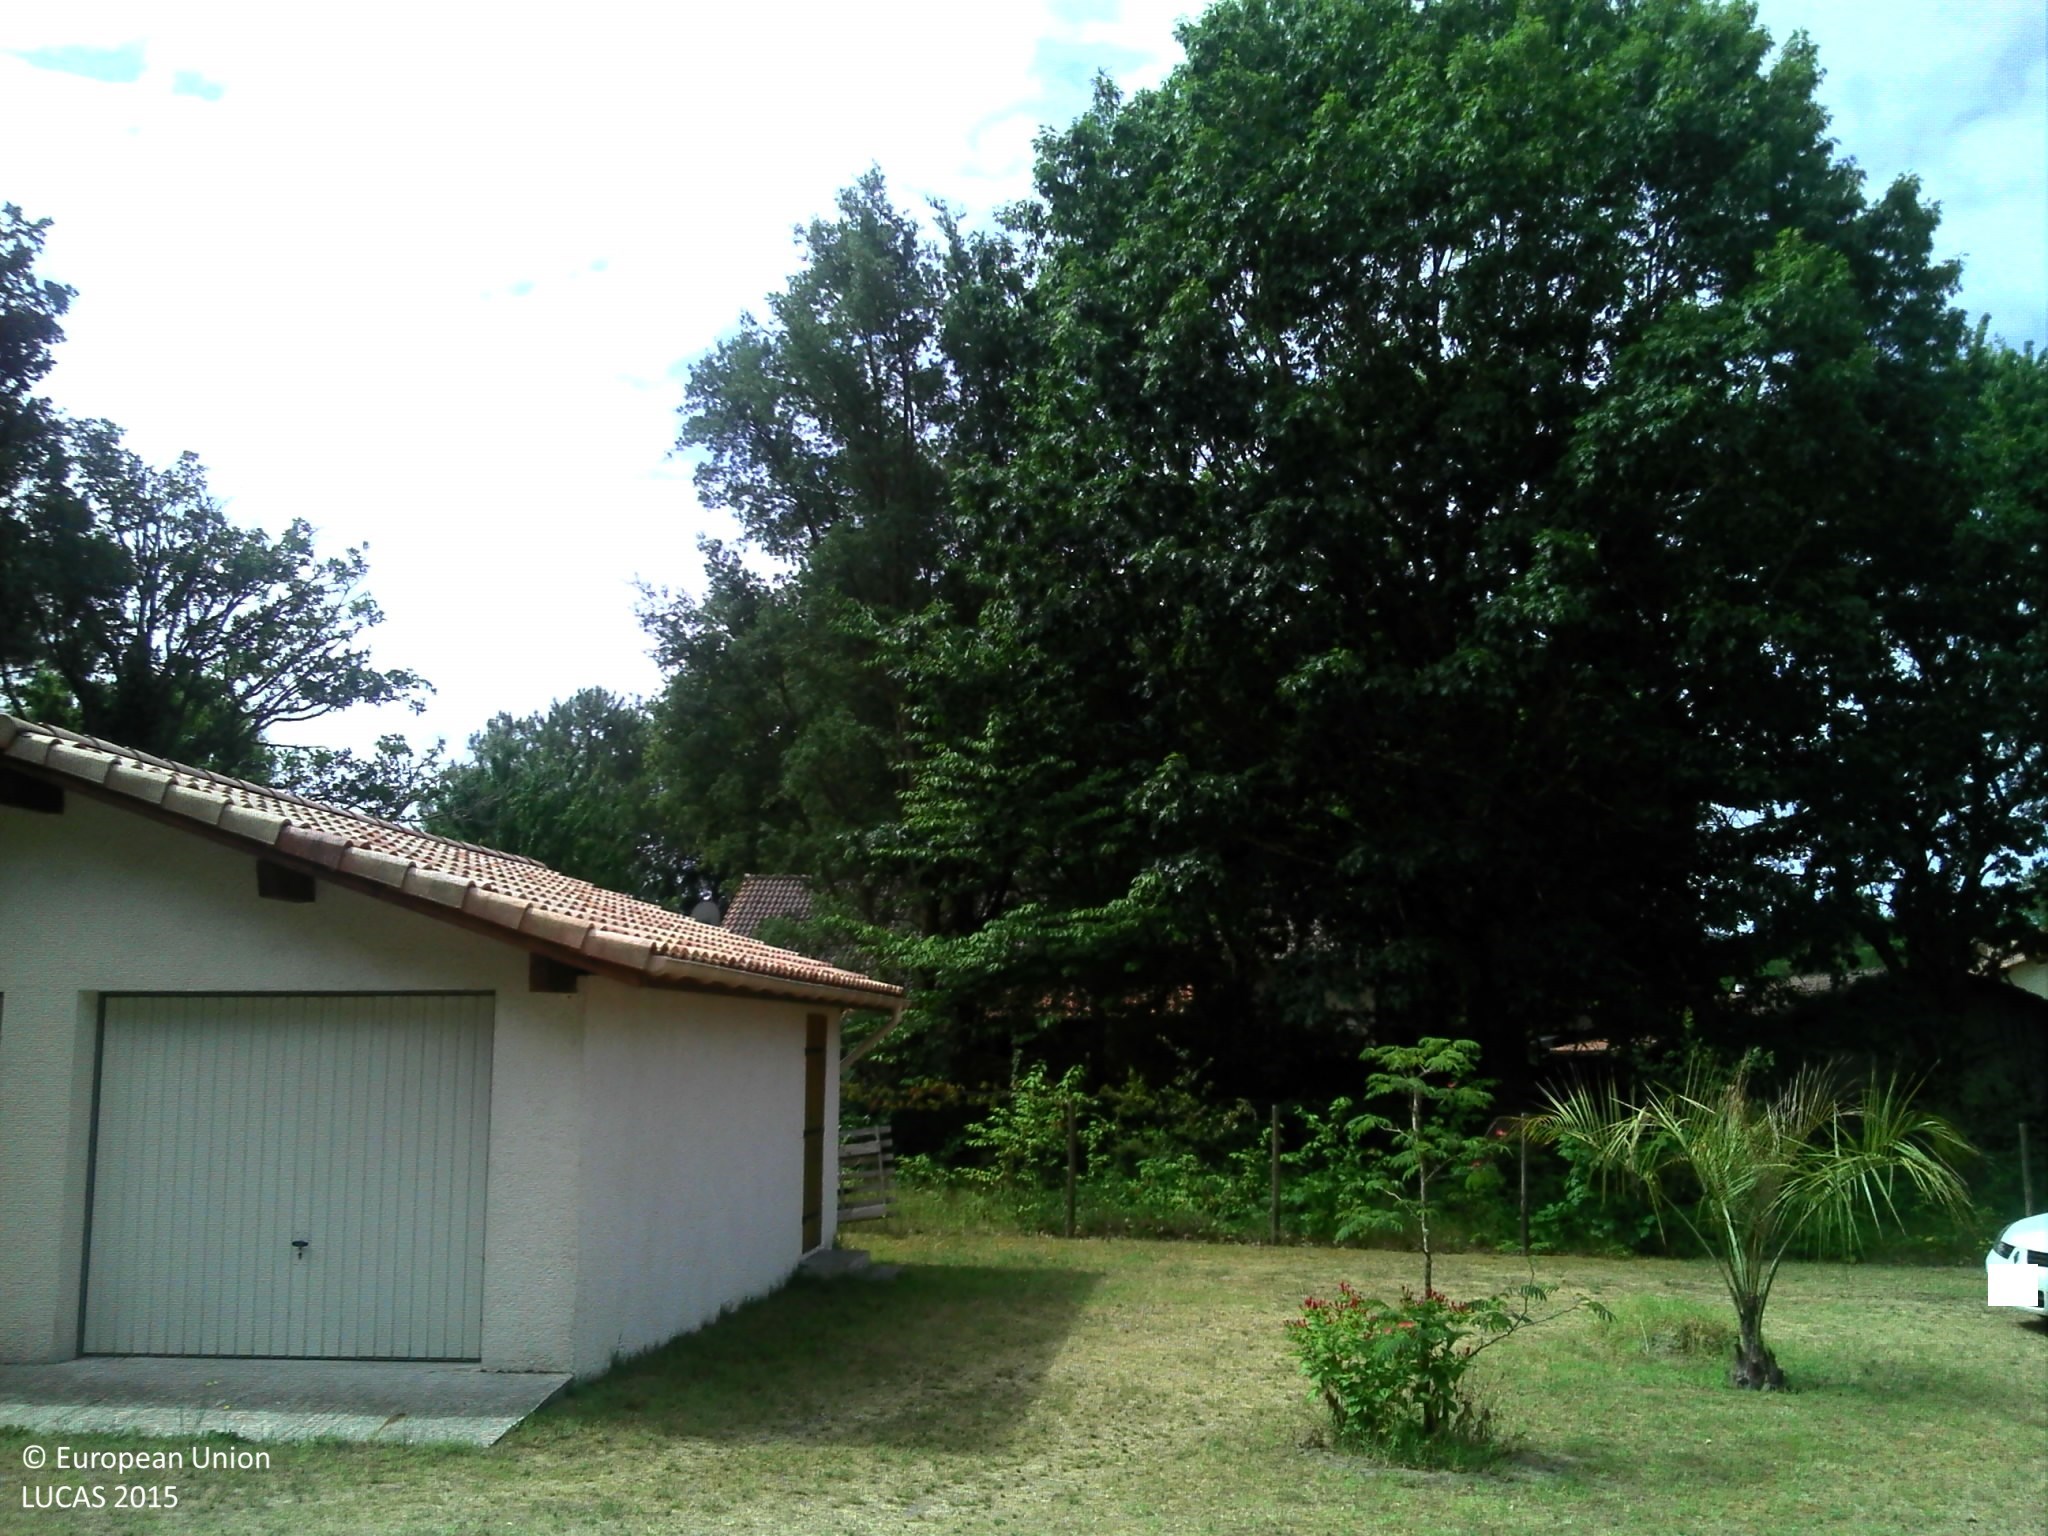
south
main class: Grassland
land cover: Grassland without tree/shrub cover
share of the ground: > 75 %
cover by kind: herbaceous plants 100 %
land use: Residential
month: July
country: FR
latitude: 43.8761
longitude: -1.3070
